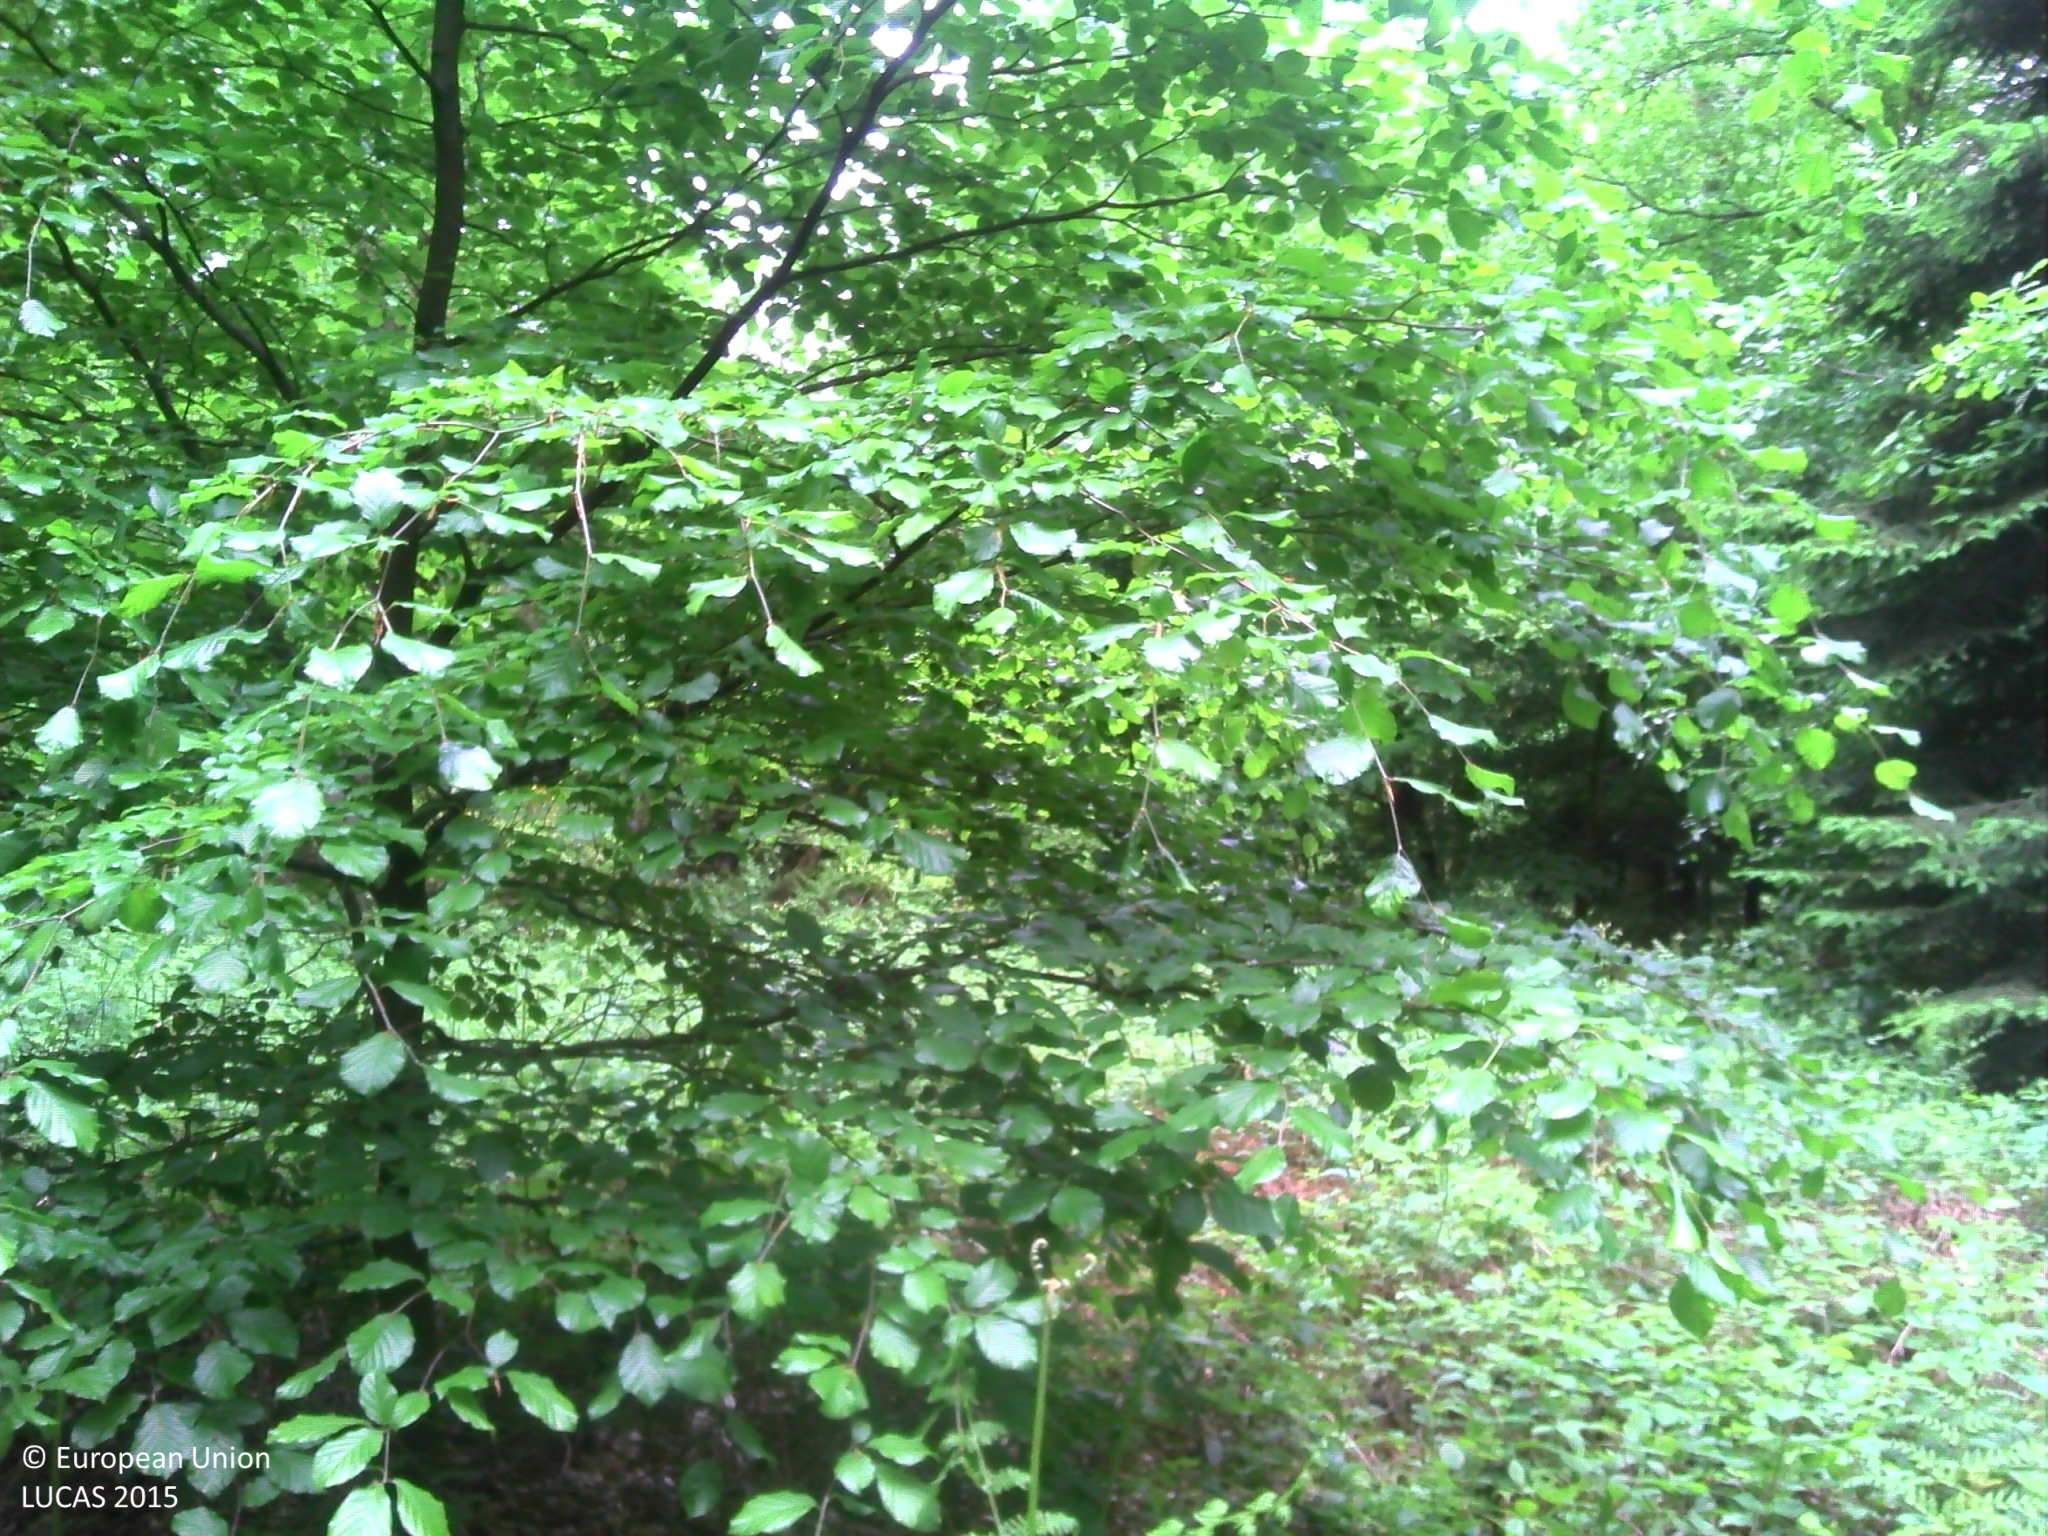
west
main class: Woodland
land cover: Other mixed woodland
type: acidophilous oak and oak-birch forest
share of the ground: > 75 %
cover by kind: coniferous forest trees 65 %, broadleaved forest trees 30 %, herbaceous plants 5 %
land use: Forestry
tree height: > 5 m
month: June
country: BE
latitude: 49.9445
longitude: 4.9108
